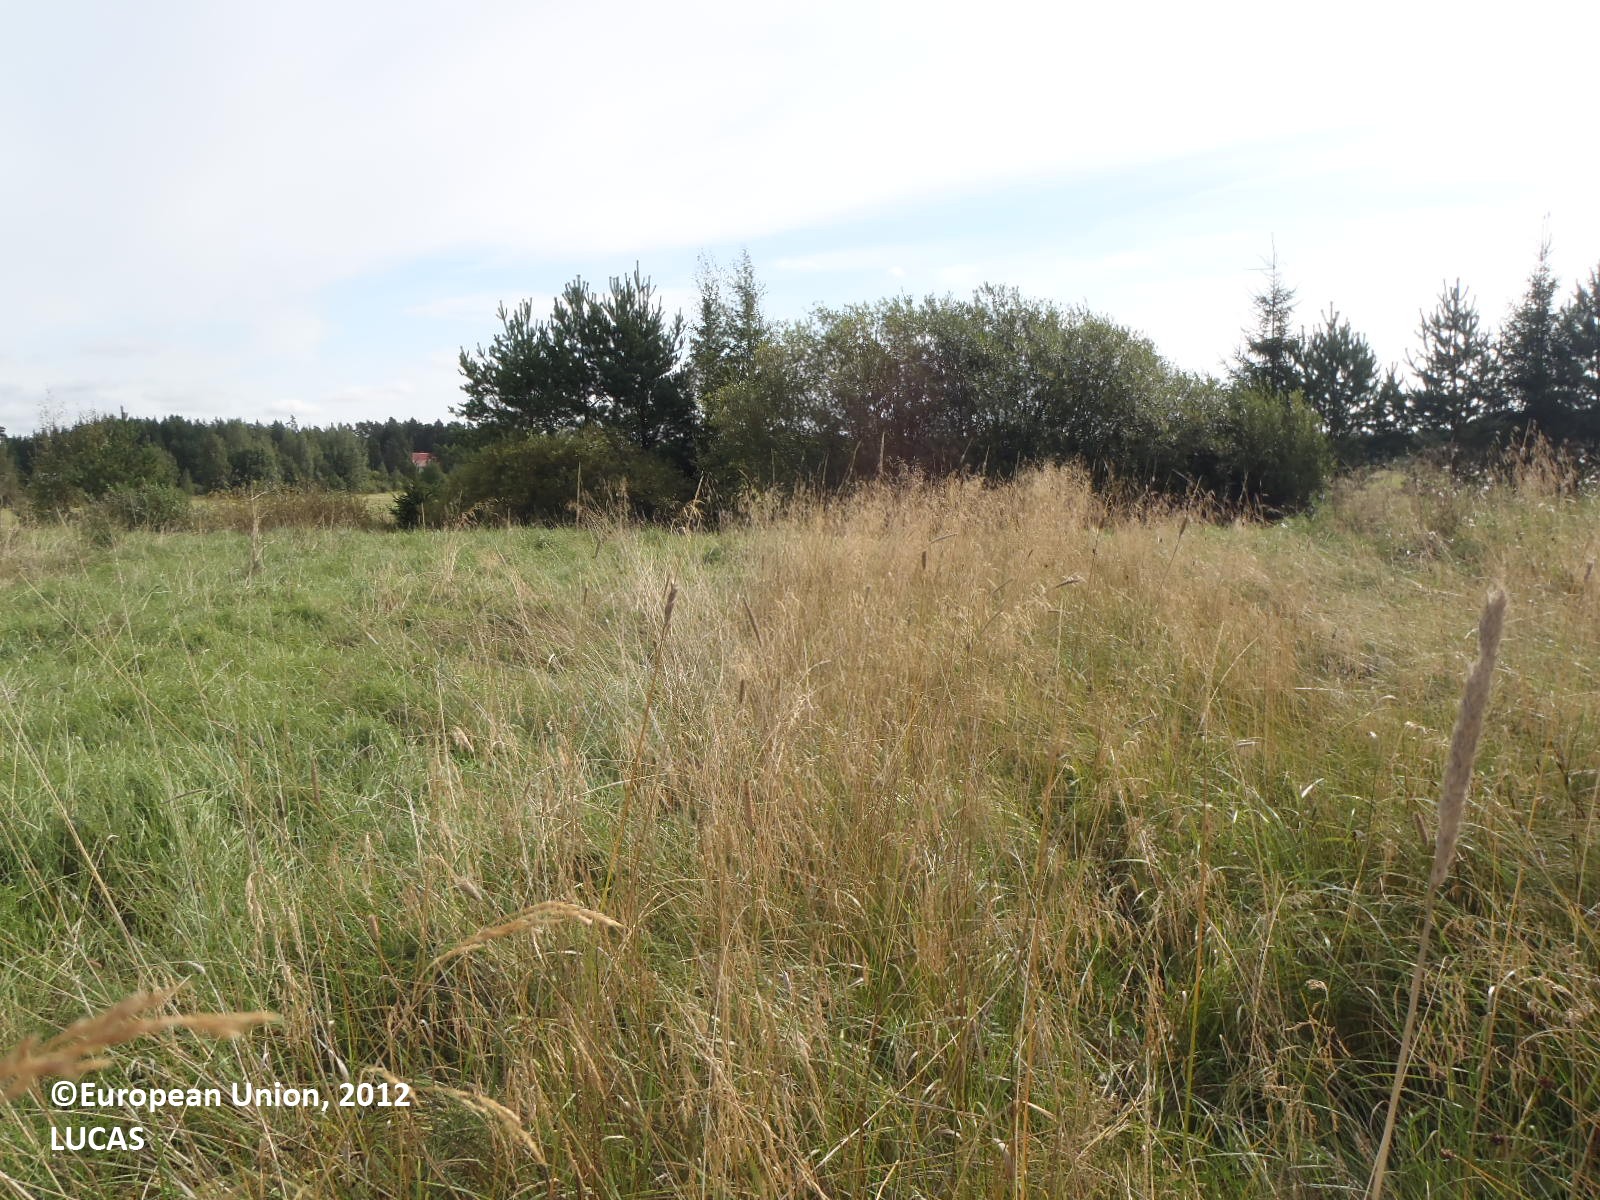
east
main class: Cropland
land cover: Temporary grasslands
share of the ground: > 75 %
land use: Agriculture (excluding fallow land and kitchen gardens)
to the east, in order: Temporary grasslands; Abandoned hedges; Ditches and canals; Abandoned hedges; Temporary grasslands; Ditches and canals; Temporary grasslands; Ditches and canals; Temporary grasslands; Ditches and canals; Temporary grasslands; Ditches and canals; Temporary grasslands; Ditches and canals; Grass margins; Common wheat
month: August
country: FI
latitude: 60.7134
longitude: 22.5496
